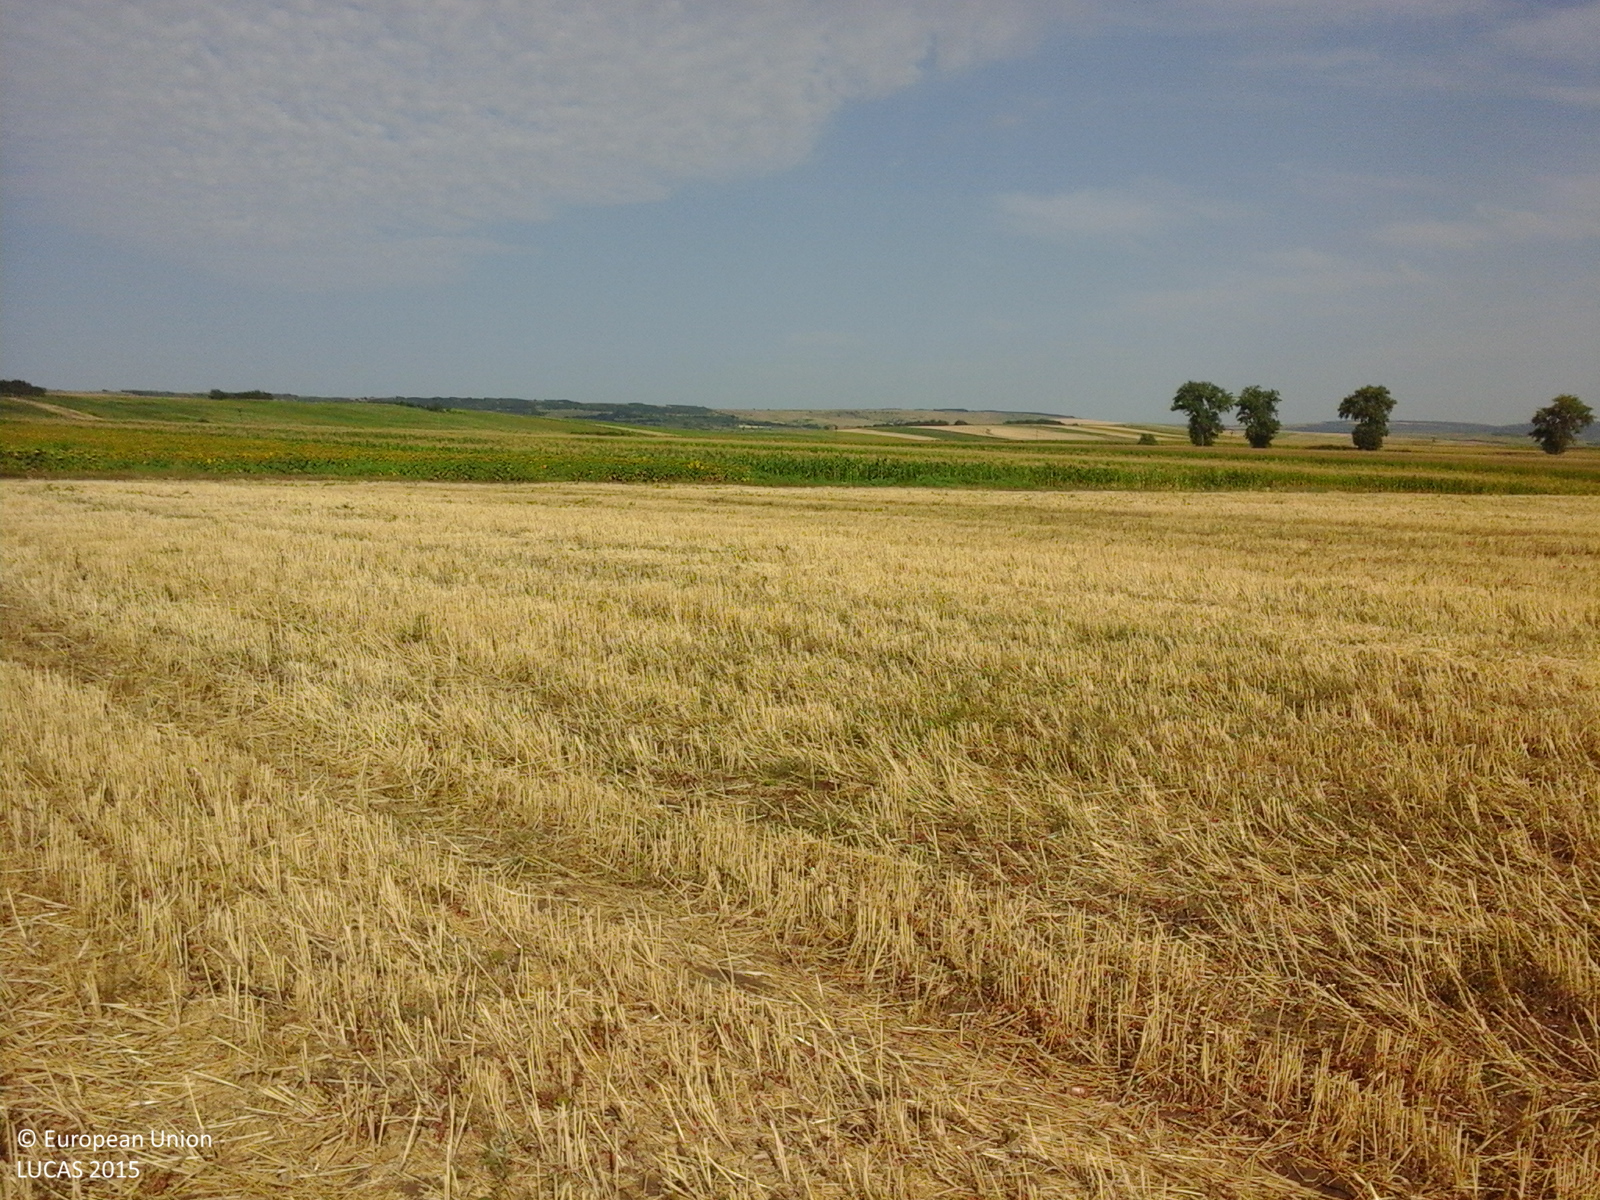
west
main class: Cropland
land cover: Common wheat
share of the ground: > 75 %
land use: Agriculture (excluding fallow land and kitchen gardens)
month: July
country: RO
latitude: 46.1485
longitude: 28.0303
